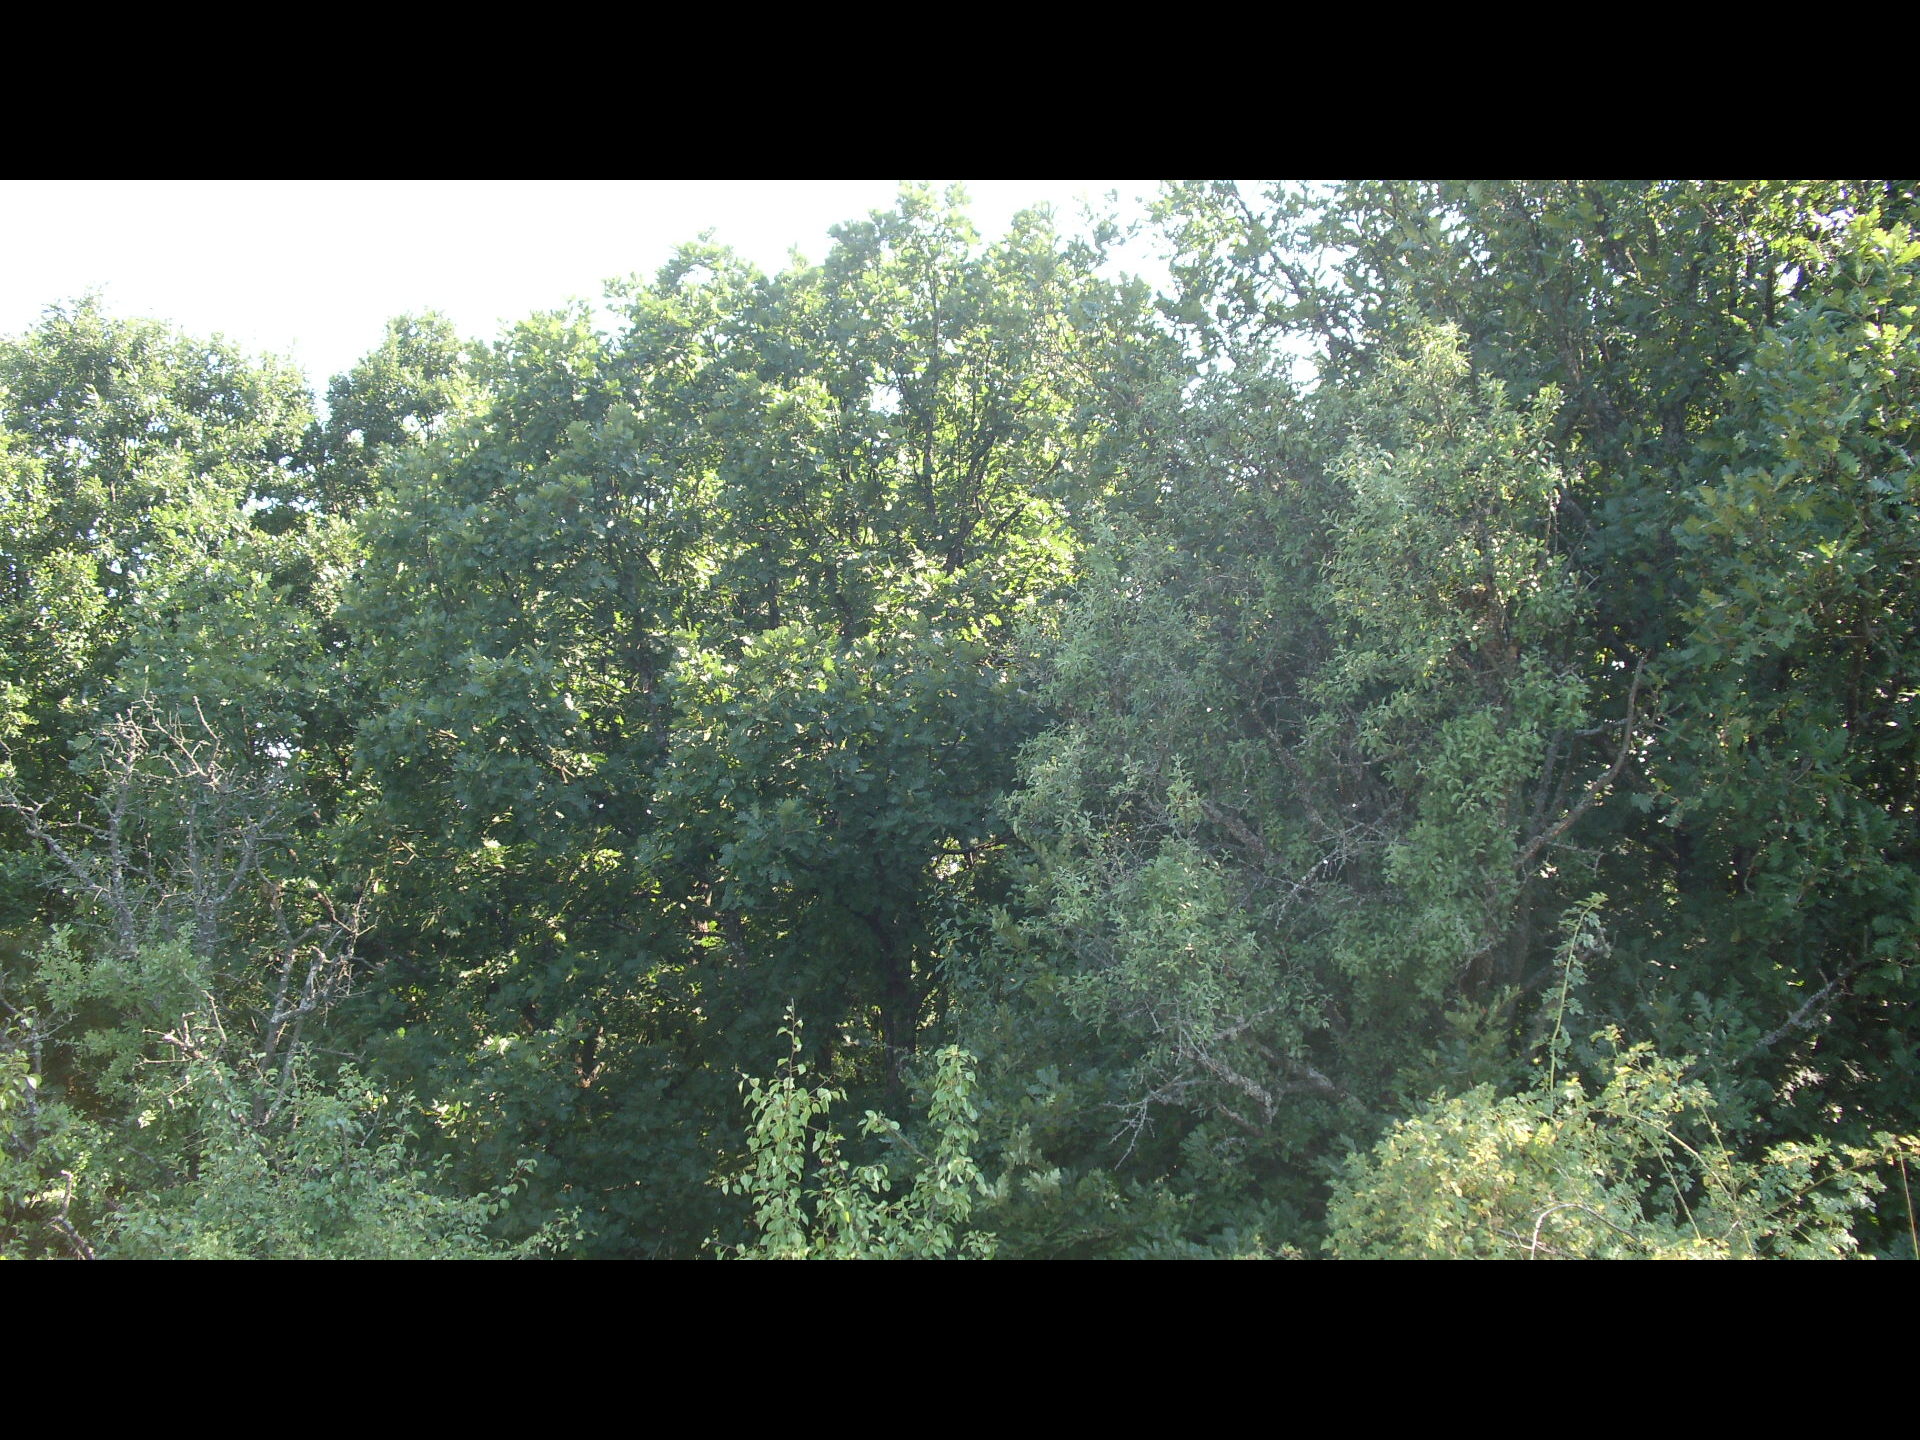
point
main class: Woodland
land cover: Broadleaved woodland
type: mesophytic deciduous forest
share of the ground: > 75 %
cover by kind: broadleaved forest trees 95 %, shrubs 5 %
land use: Forestry
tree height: > 5 m
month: July
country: BG
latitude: 43.7027
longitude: 22.7799
